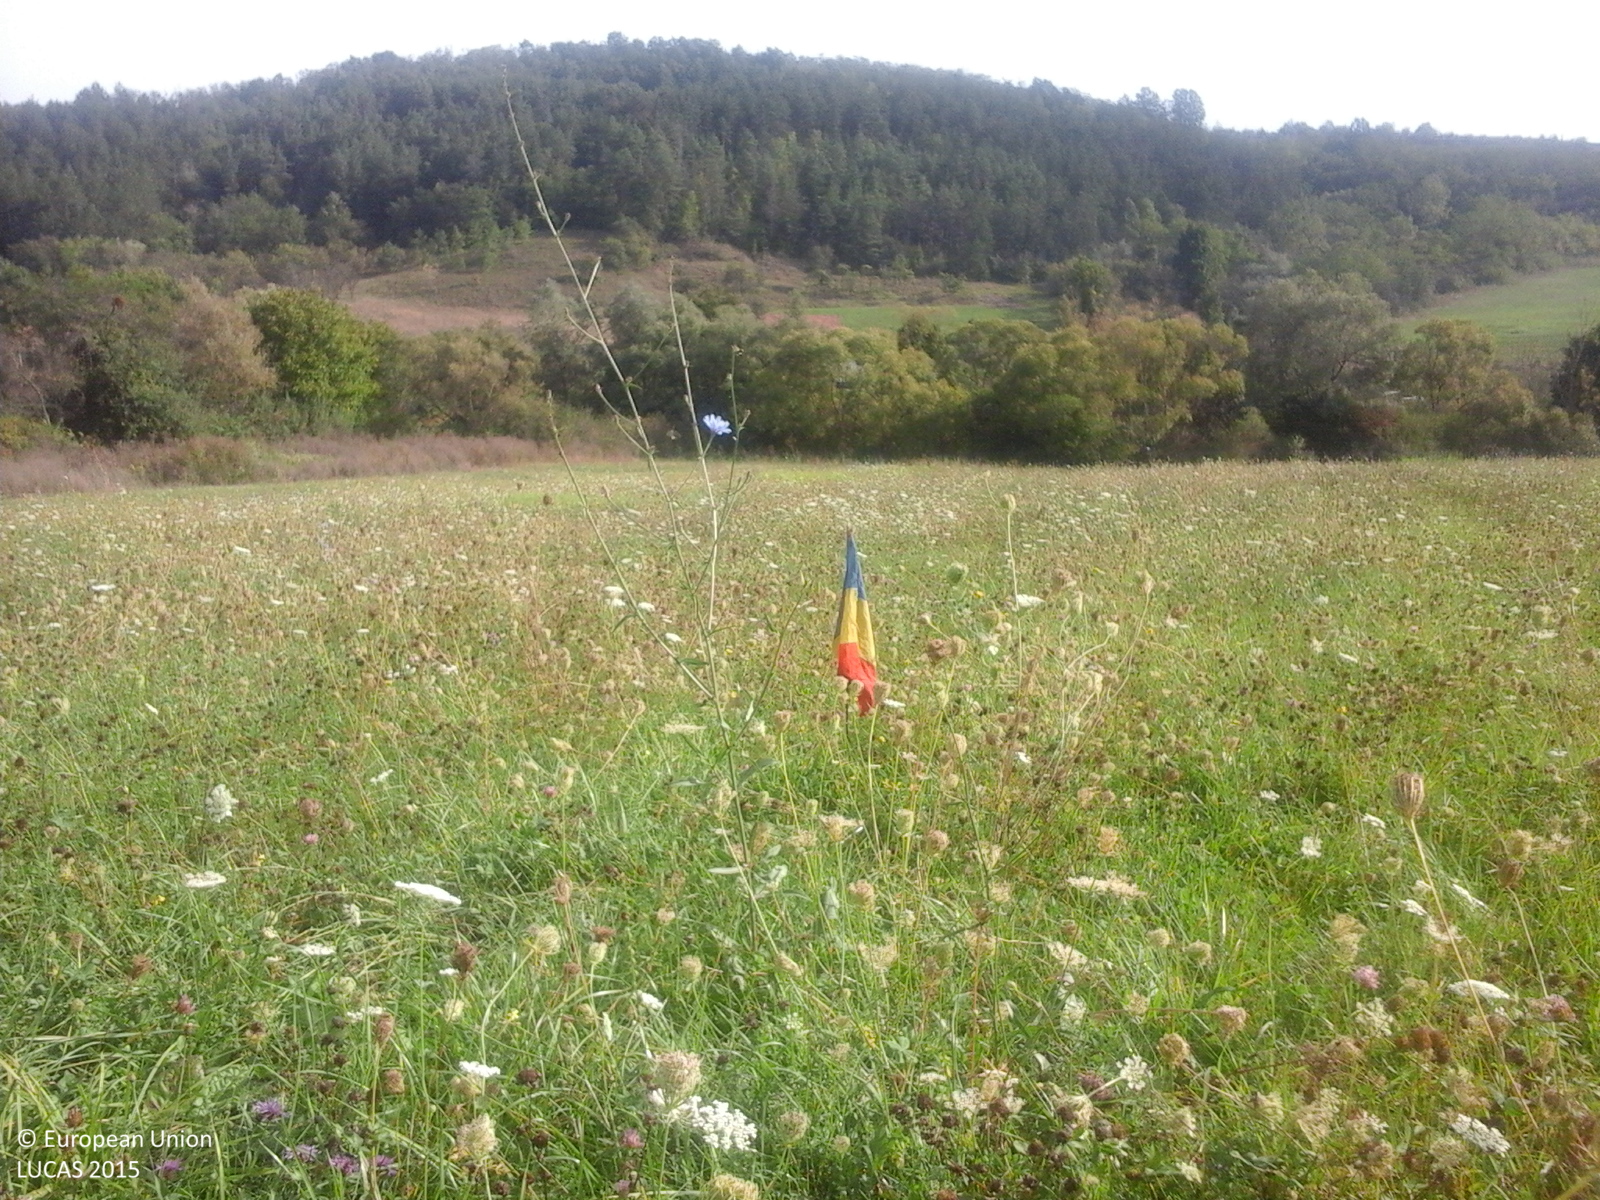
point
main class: Grassland
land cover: Grassland without tree/shrub cover
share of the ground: > 75 %
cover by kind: herbaceous plants 100 %
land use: Agriculture (excluding fallow land and kitchen gardens)
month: September
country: RO
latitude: 46.9509
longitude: 23.3516
